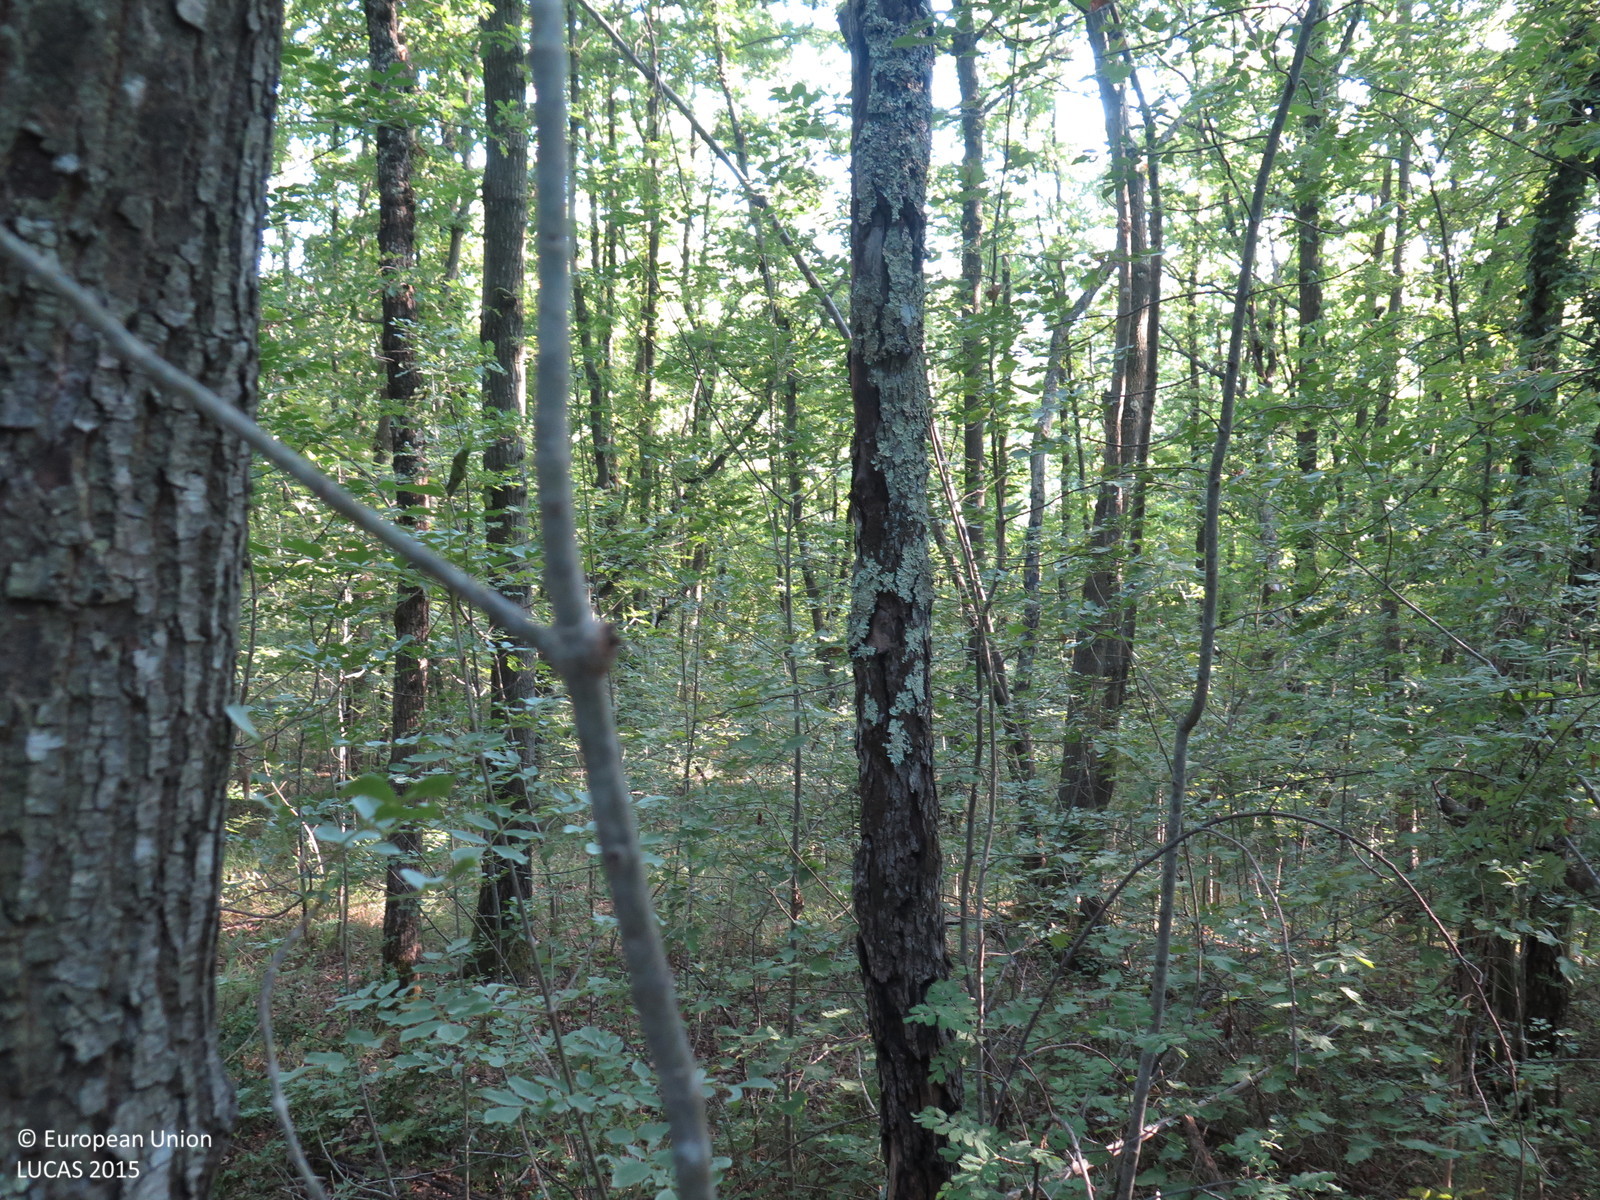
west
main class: Woodland
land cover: Broadleaved woodland
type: acidophilous oak and oak-birch forest
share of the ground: > 75 %
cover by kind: broadleaved forest trees 90 %, shrubs 5 %, herbaceous plants 5 %
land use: Semi-natural and natural areas not in use
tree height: > 5 m
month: August
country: HR
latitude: 45.3179
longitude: 14.0643
